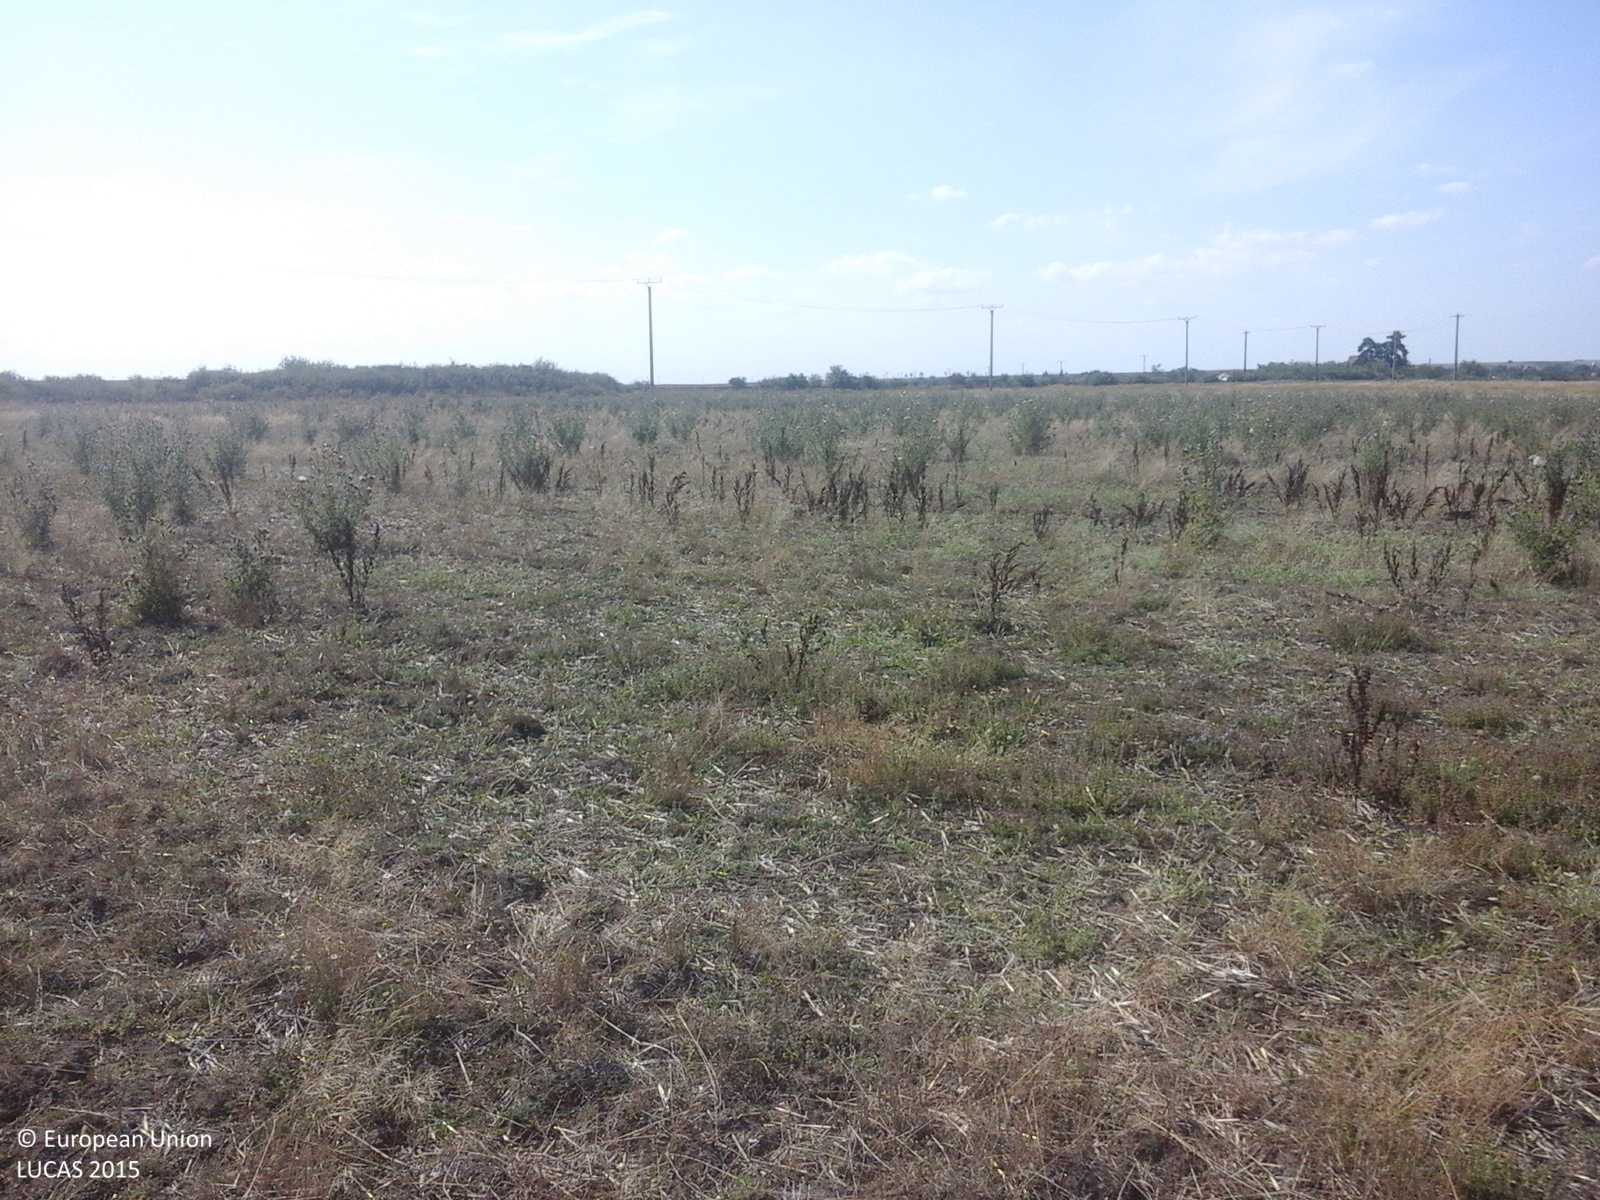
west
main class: Grassland
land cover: Spontaneously vegetated surfaces
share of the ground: > 75 %
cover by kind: herbaceous plants 100 %
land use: Fallow land
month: August
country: RO
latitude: 45.3517
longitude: 21.4548
